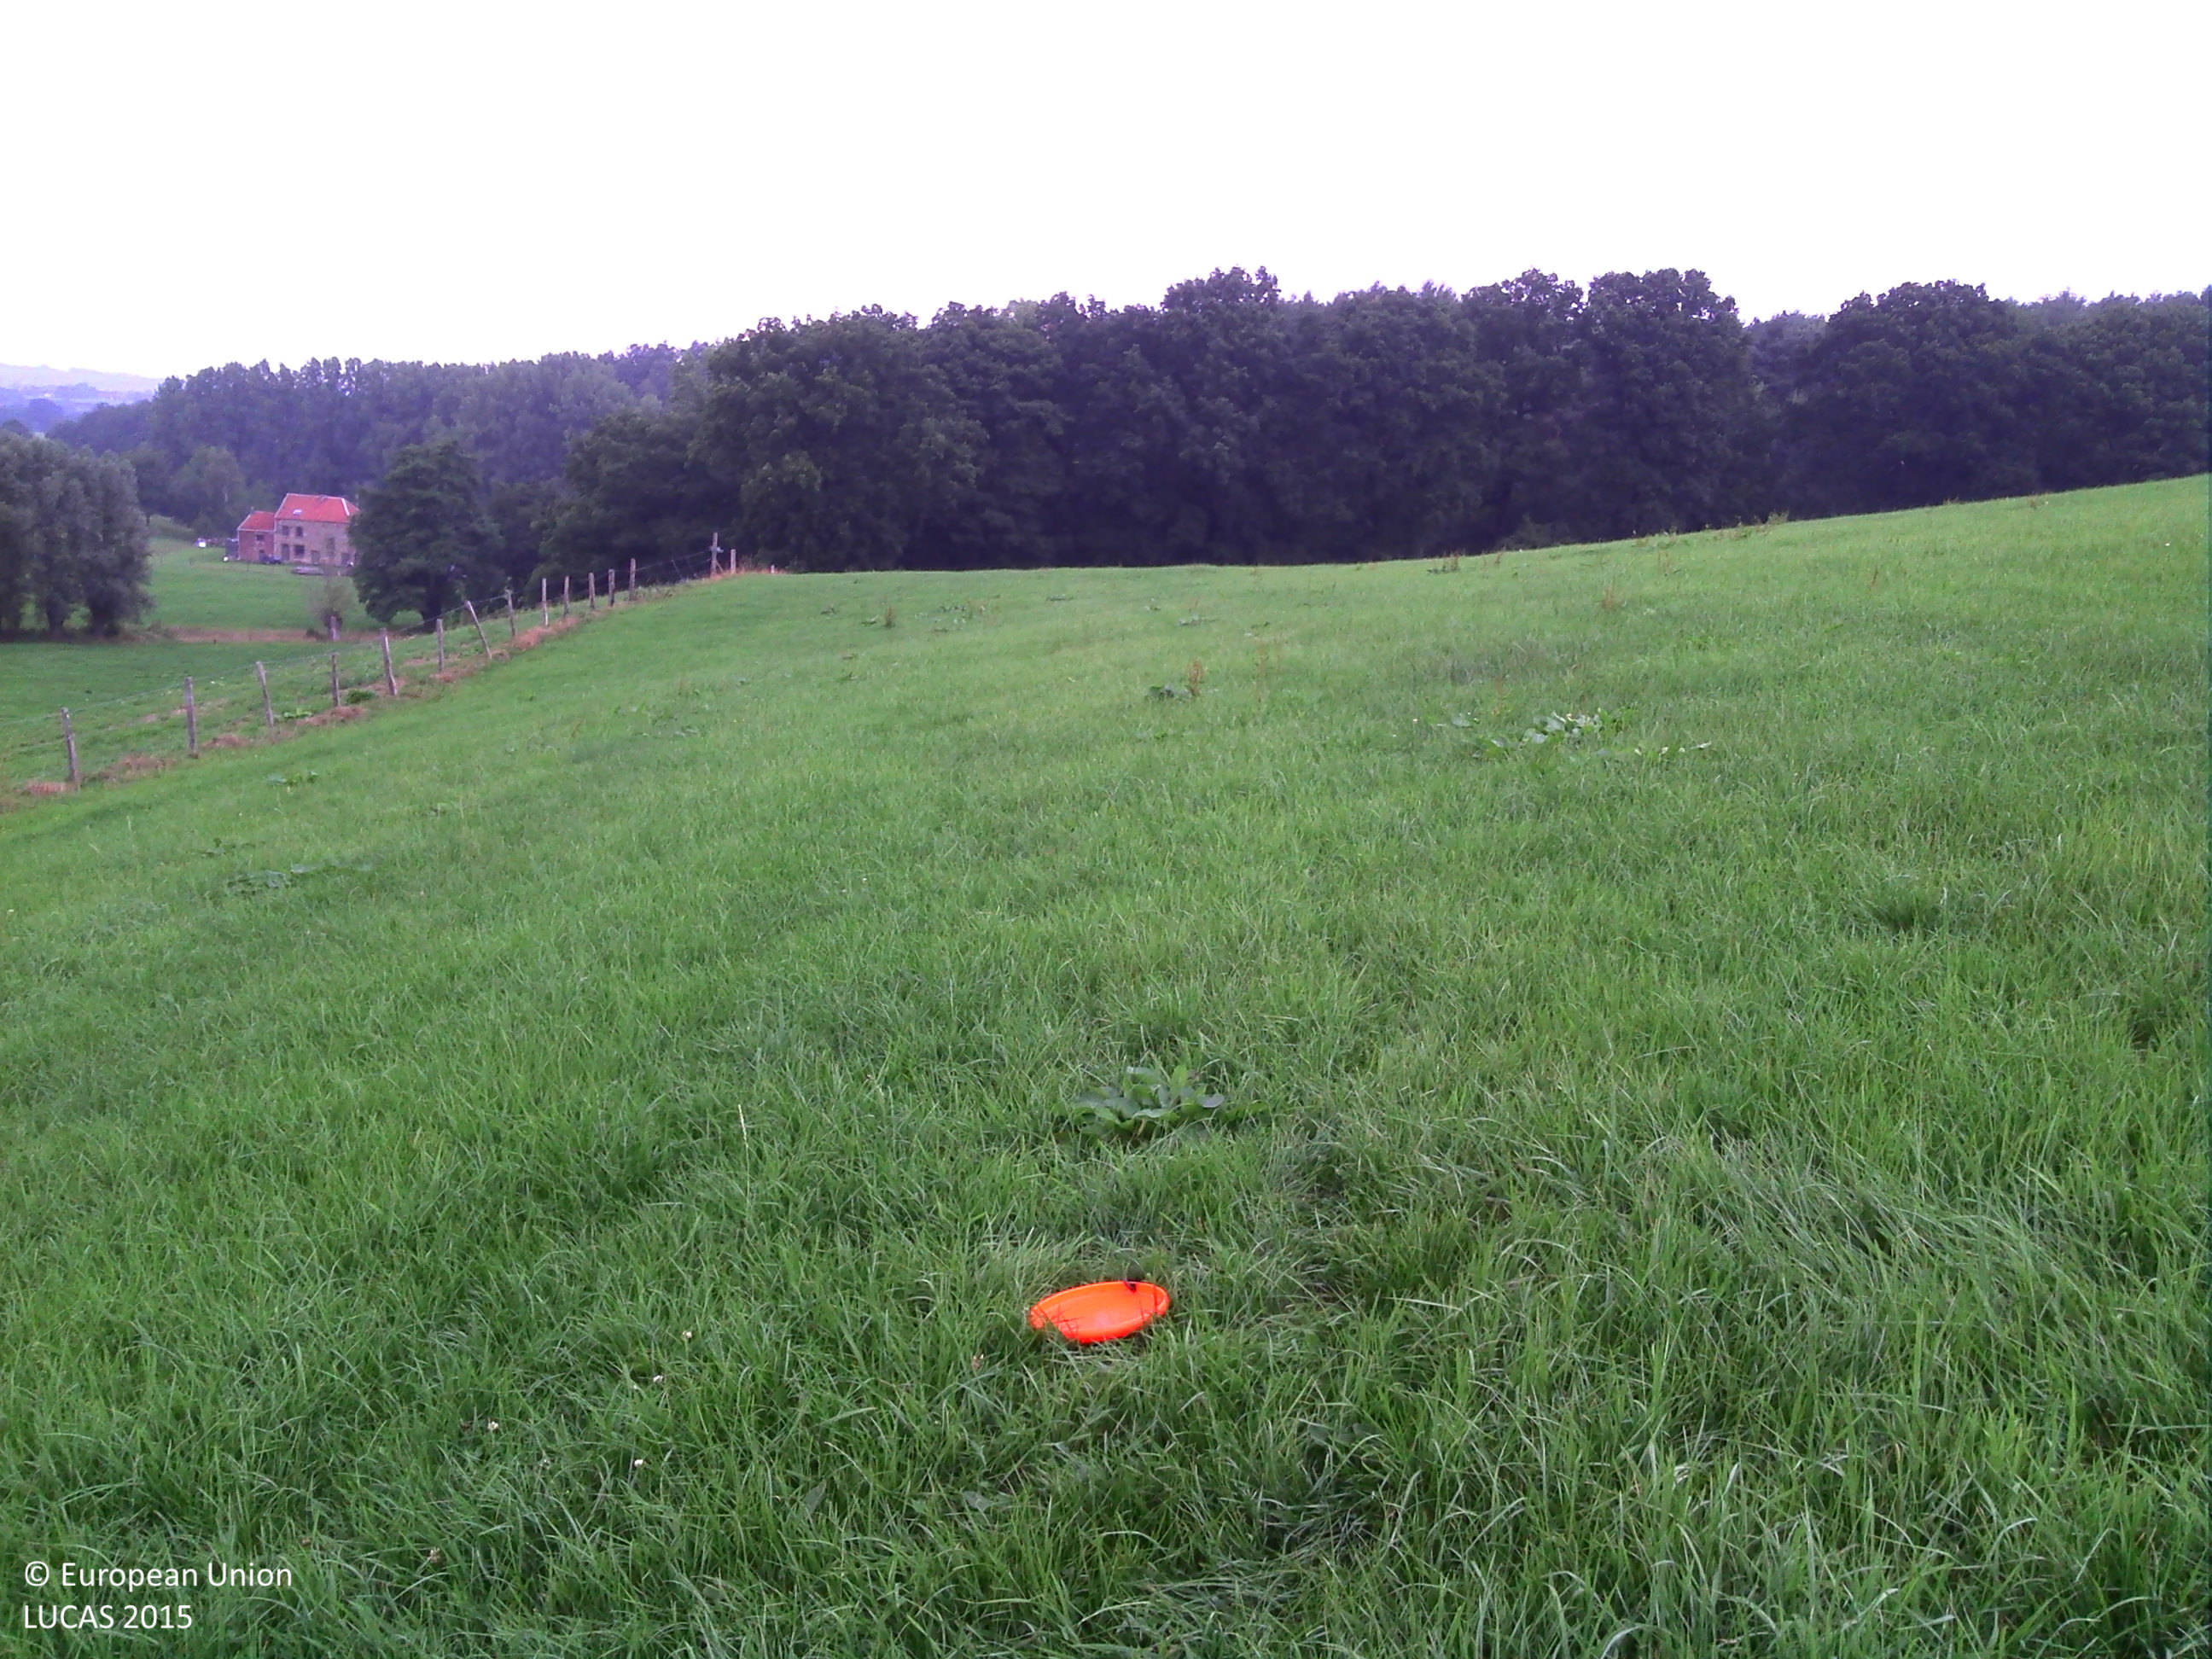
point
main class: Grassland
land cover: Grassland without tree/shrub cover
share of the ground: > 75 %
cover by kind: herbaceous plants 100 %
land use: Agriculture (excluding fallow land and kitchen gardens)
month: August
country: BE
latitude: 50.6670
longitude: 5.8533
